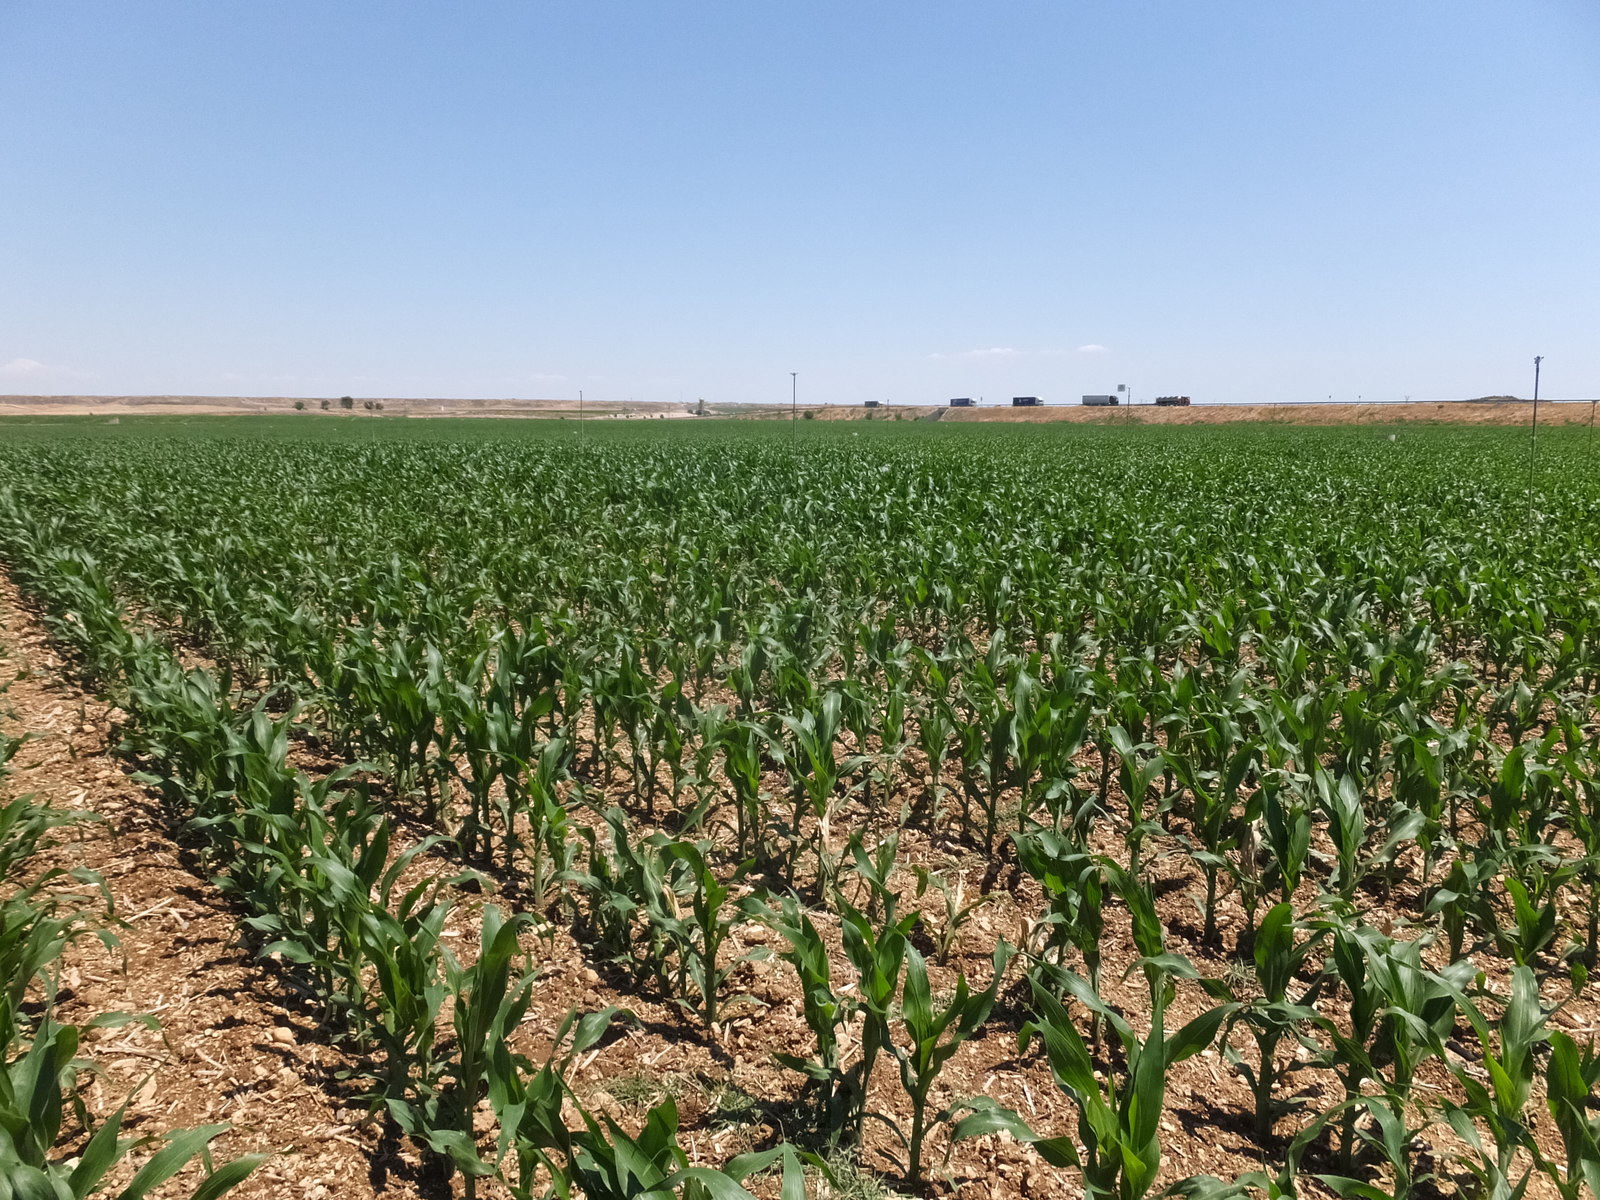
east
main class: Cropland
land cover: Maize
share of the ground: 10 - 25 %
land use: Agriculture (excluding fallow land and kitchen gardens)
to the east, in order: Maize
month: June
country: ES
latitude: 41.5085
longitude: 0.0534
